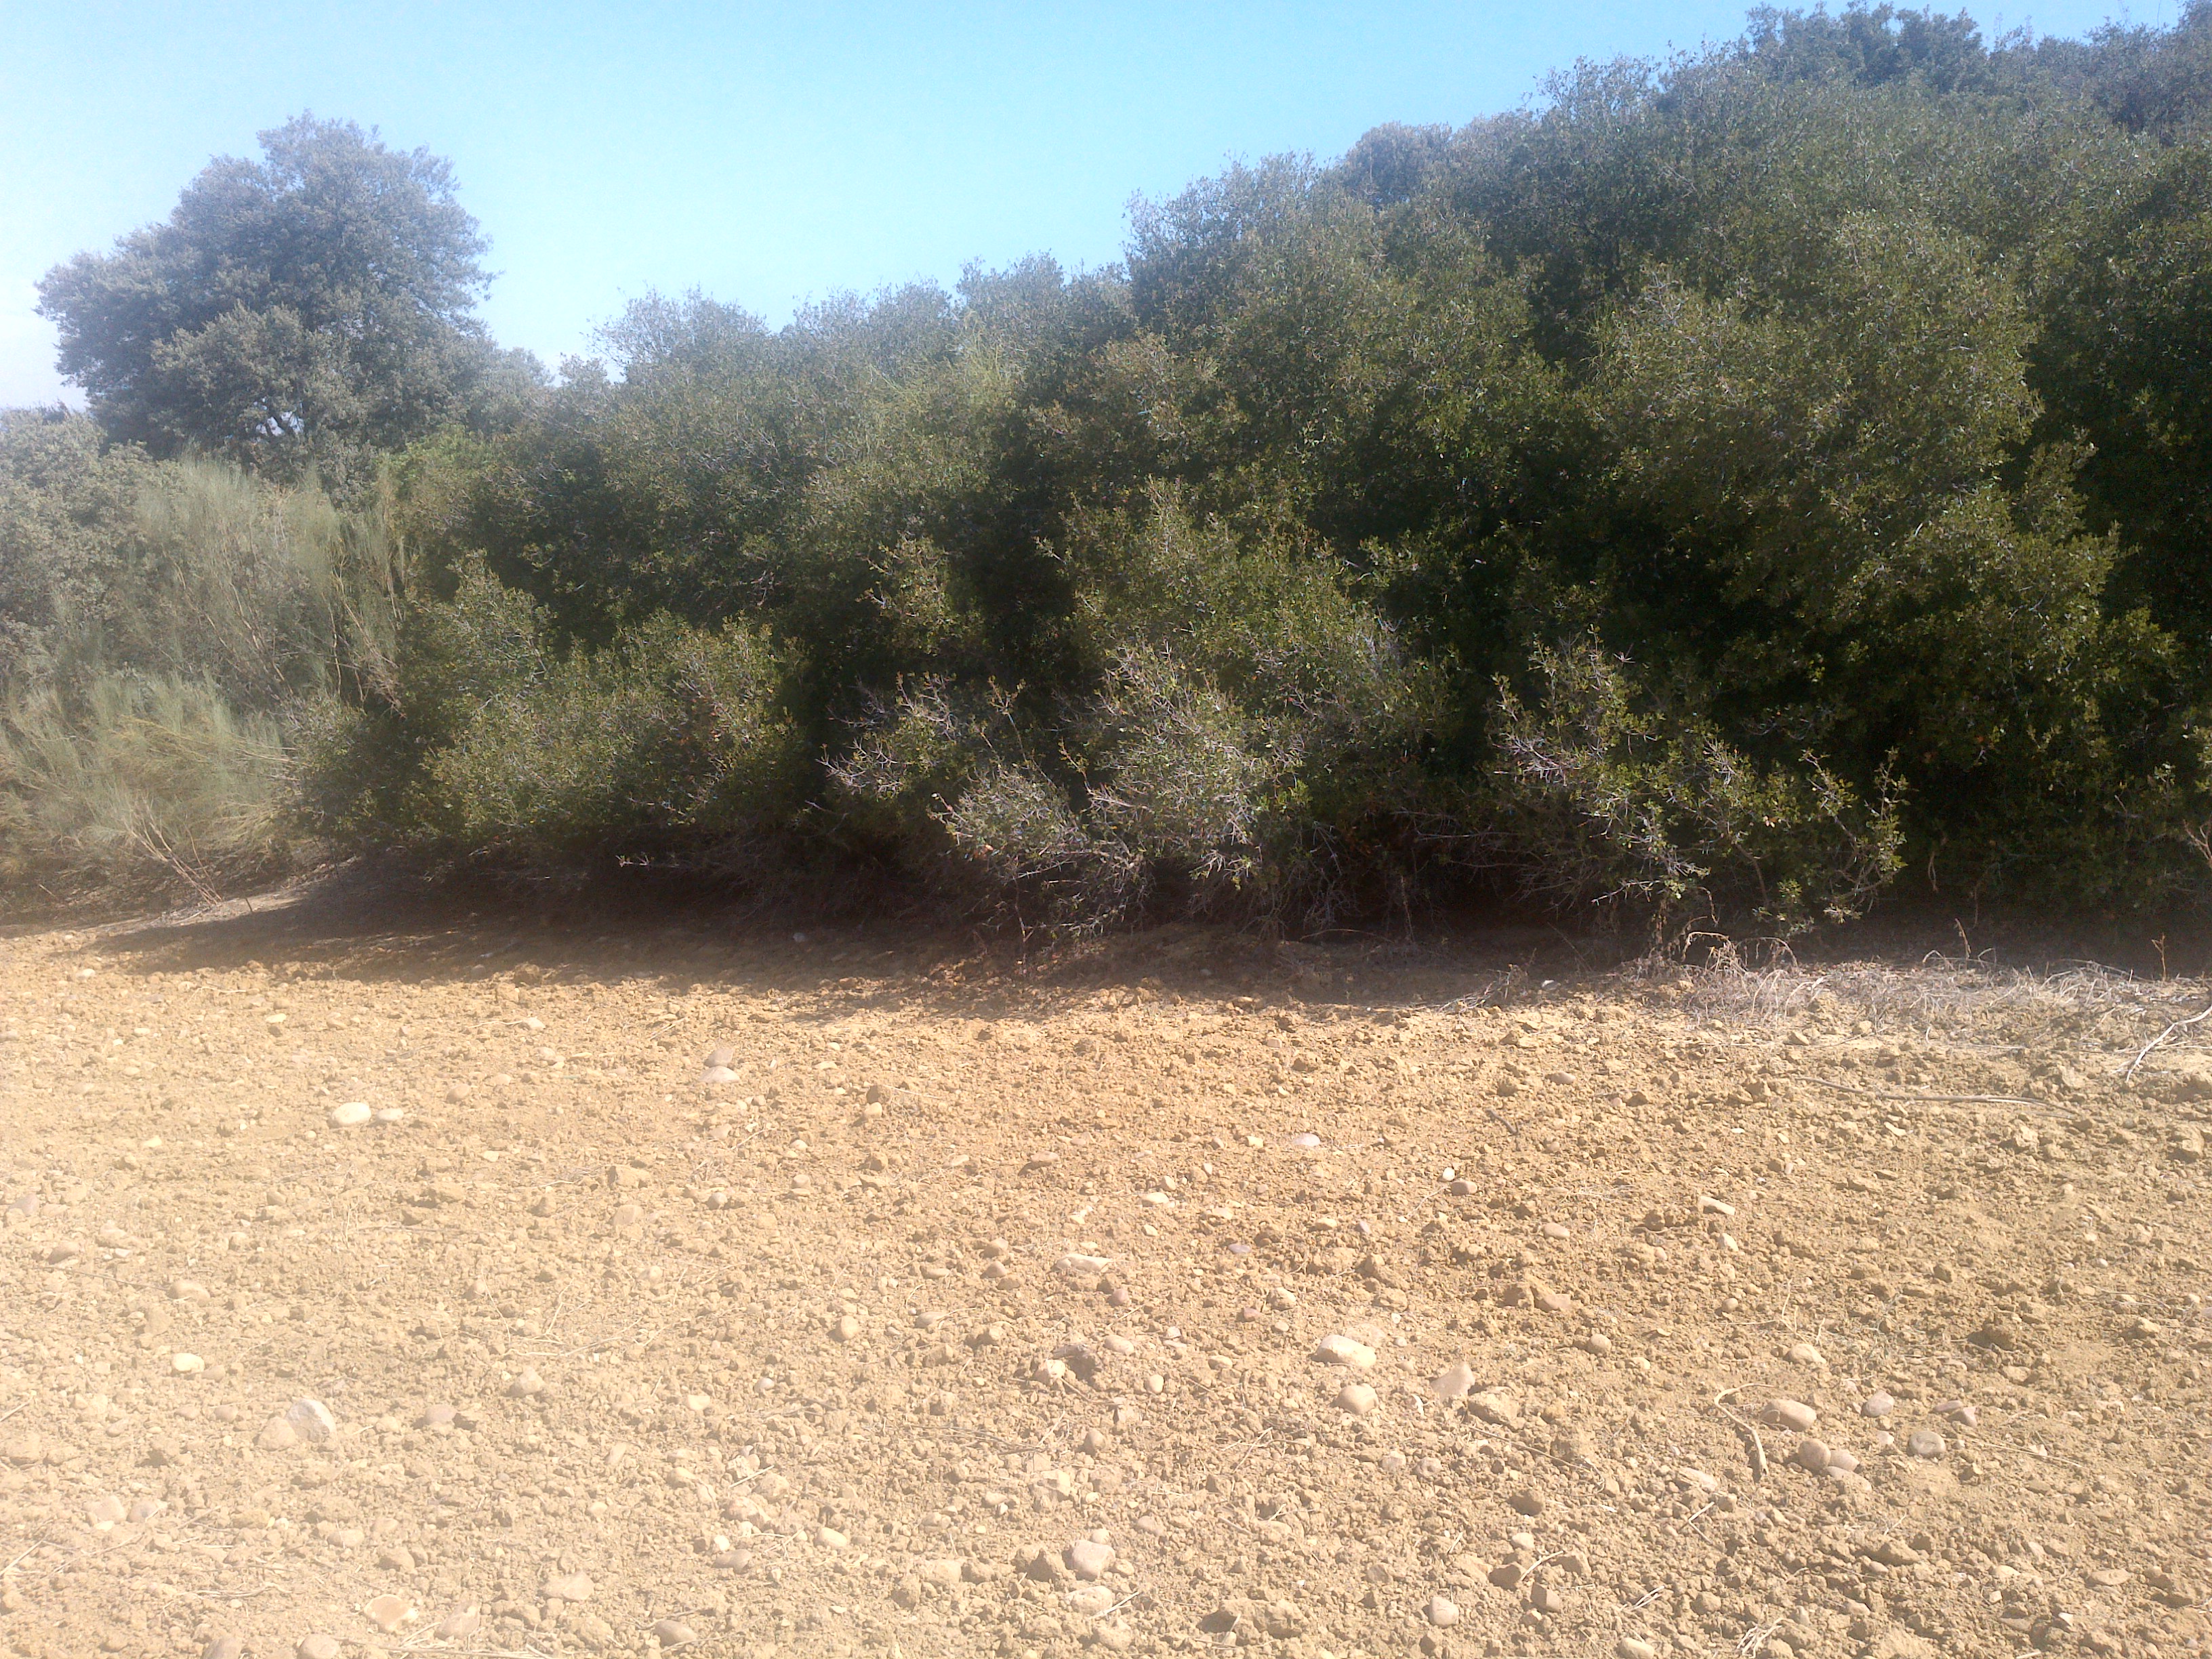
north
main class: Woodland
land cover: Broadleaved woodland
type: broadleaved evergreen forest
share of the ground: 25 - 50 %
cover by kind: shrubs 50 %, broadleaved forest trees 25 %, unconsolidated bare surface 15 %, herbaceous plants 10 %
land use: Semi-natural and natural areas not in use
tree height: < 5 m
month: June
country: ES
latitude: 37.7241
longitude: -4.9101
